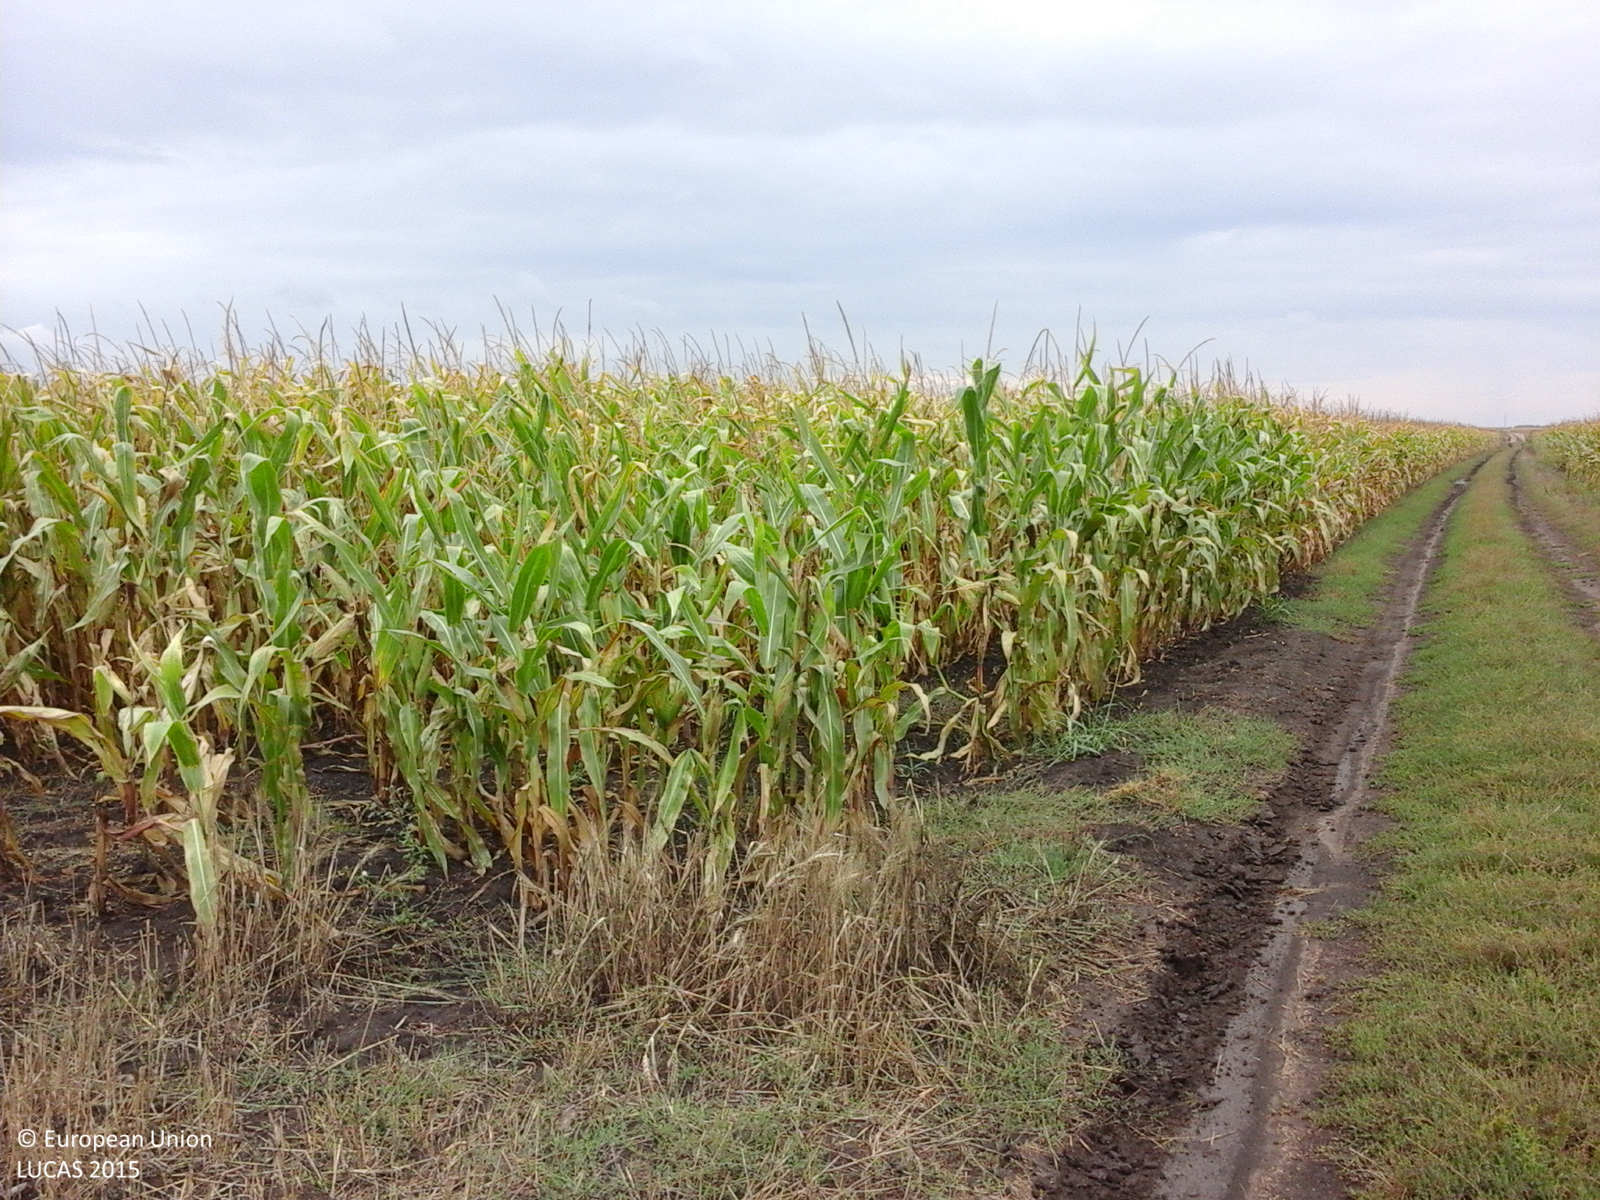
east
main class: Cropland
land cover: Maize
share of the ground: > 75 %
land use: Agriculture (excluding fallow land and kitchen gardens)
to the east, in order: Maize; Grass margins; Tracks; Grass margins; Maize
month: August
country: RO
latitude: 45.8236
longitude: 20.7738
